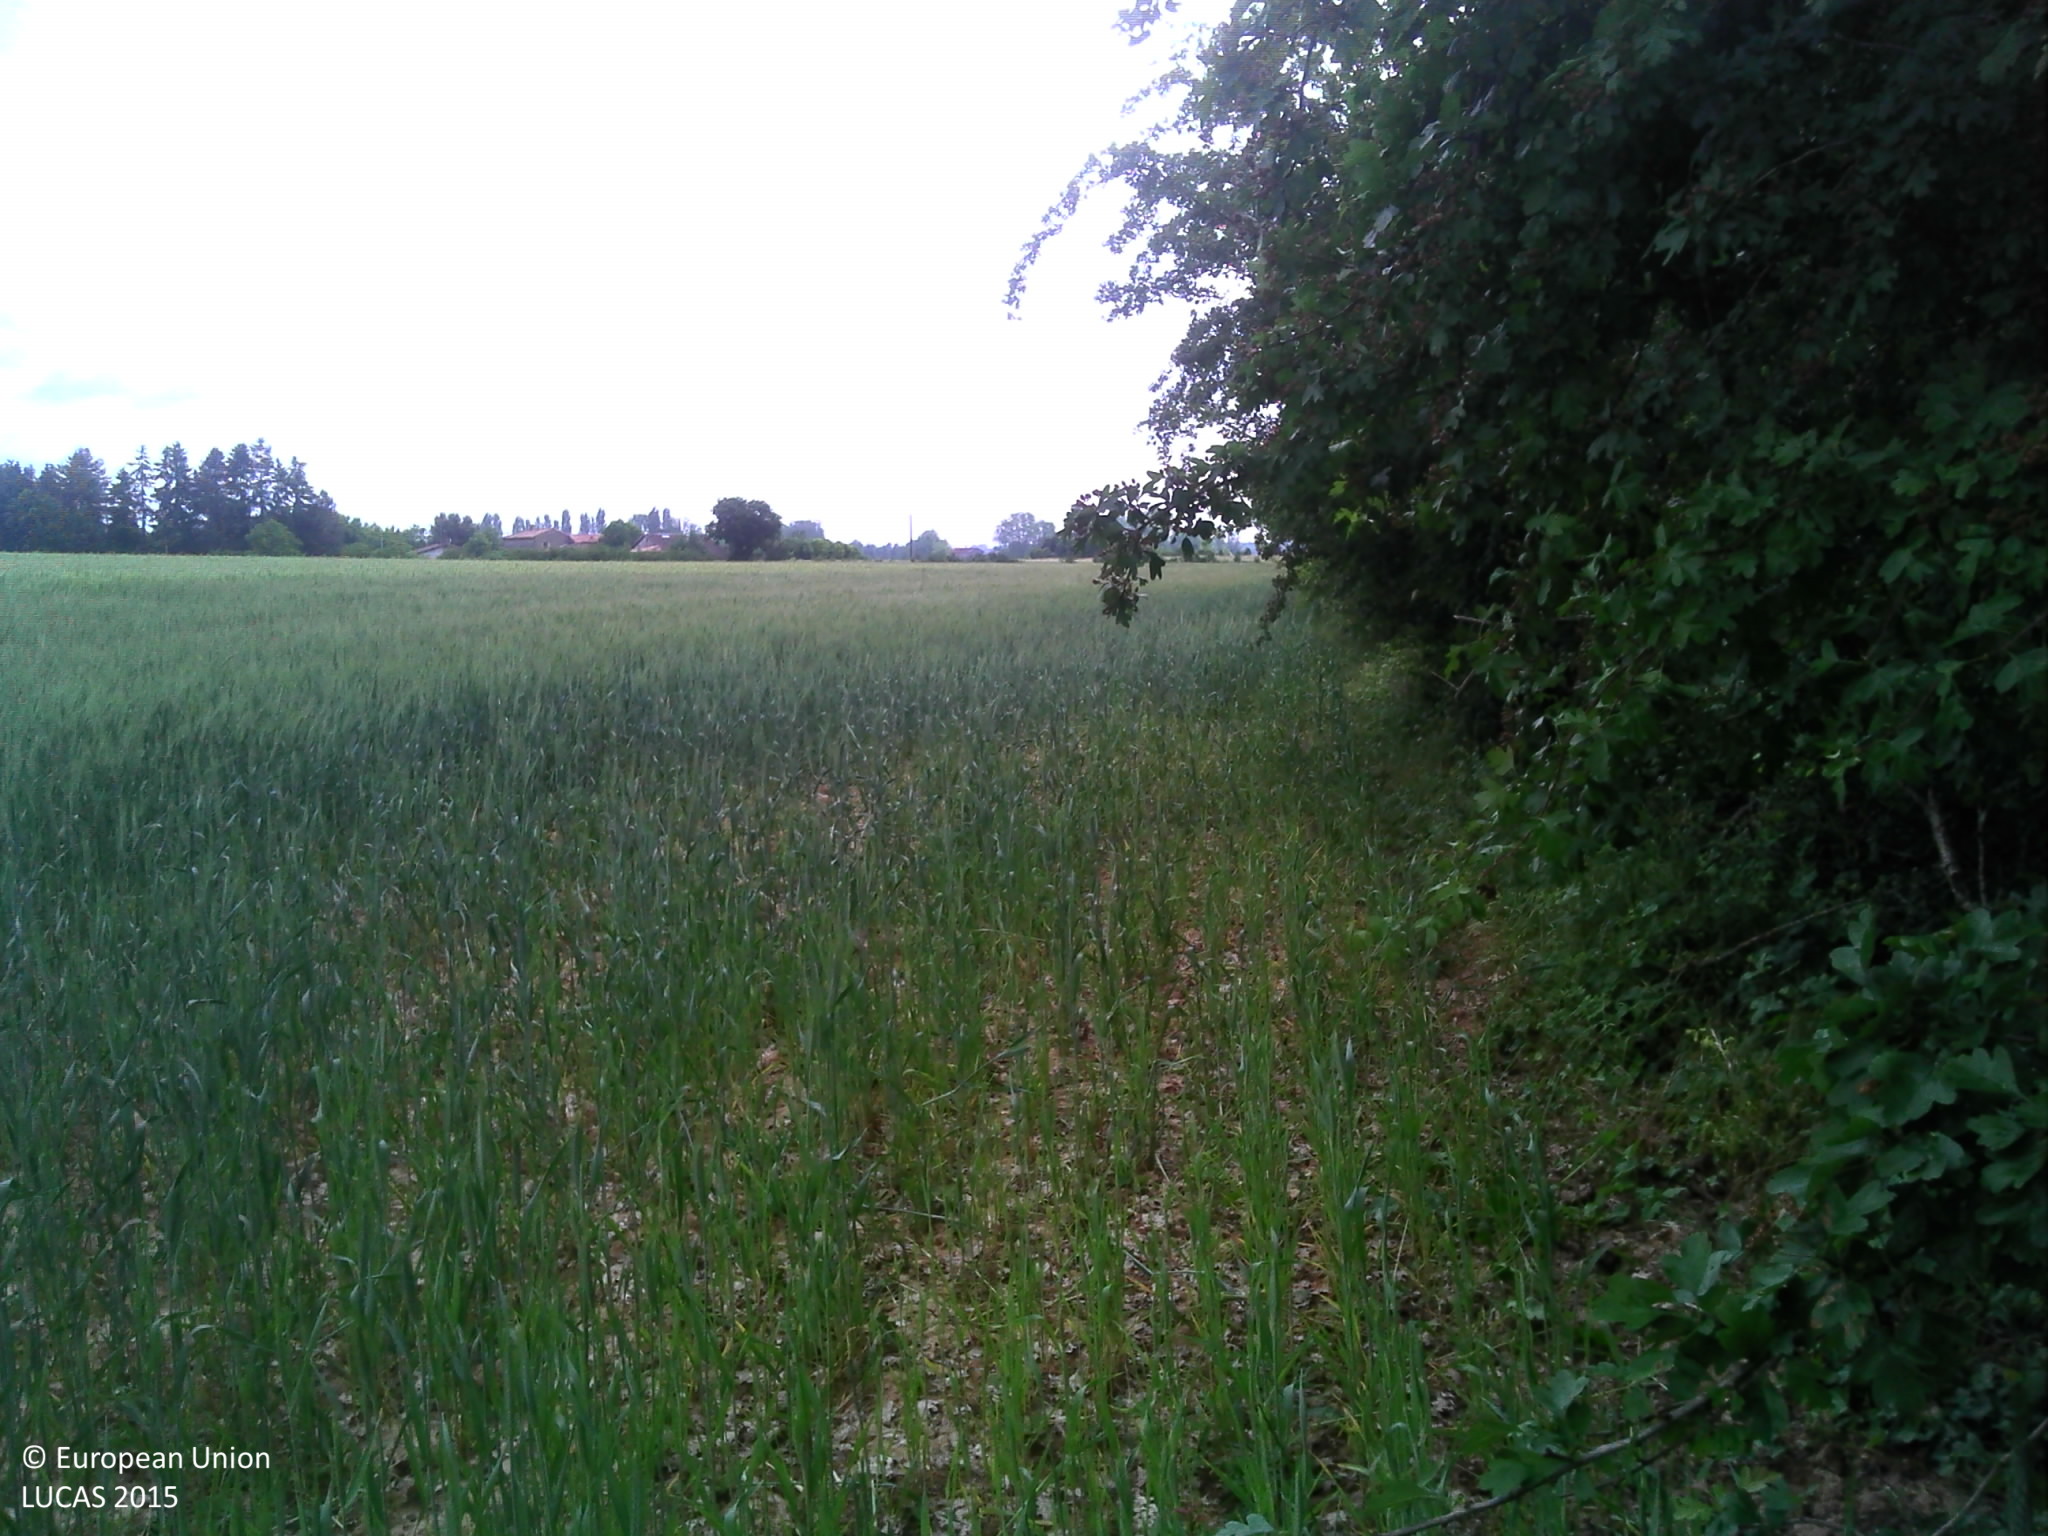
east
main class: Cropland
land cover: Triticale
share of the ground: > 75 %
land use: Agriculture (excluding fallow land and kitchen gardens)
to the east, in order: Triticale; Abandoned hedges; Ditches and canals; Grass margins; Triticale
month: May
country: FR
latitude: 43.8011
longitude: 1.7123
